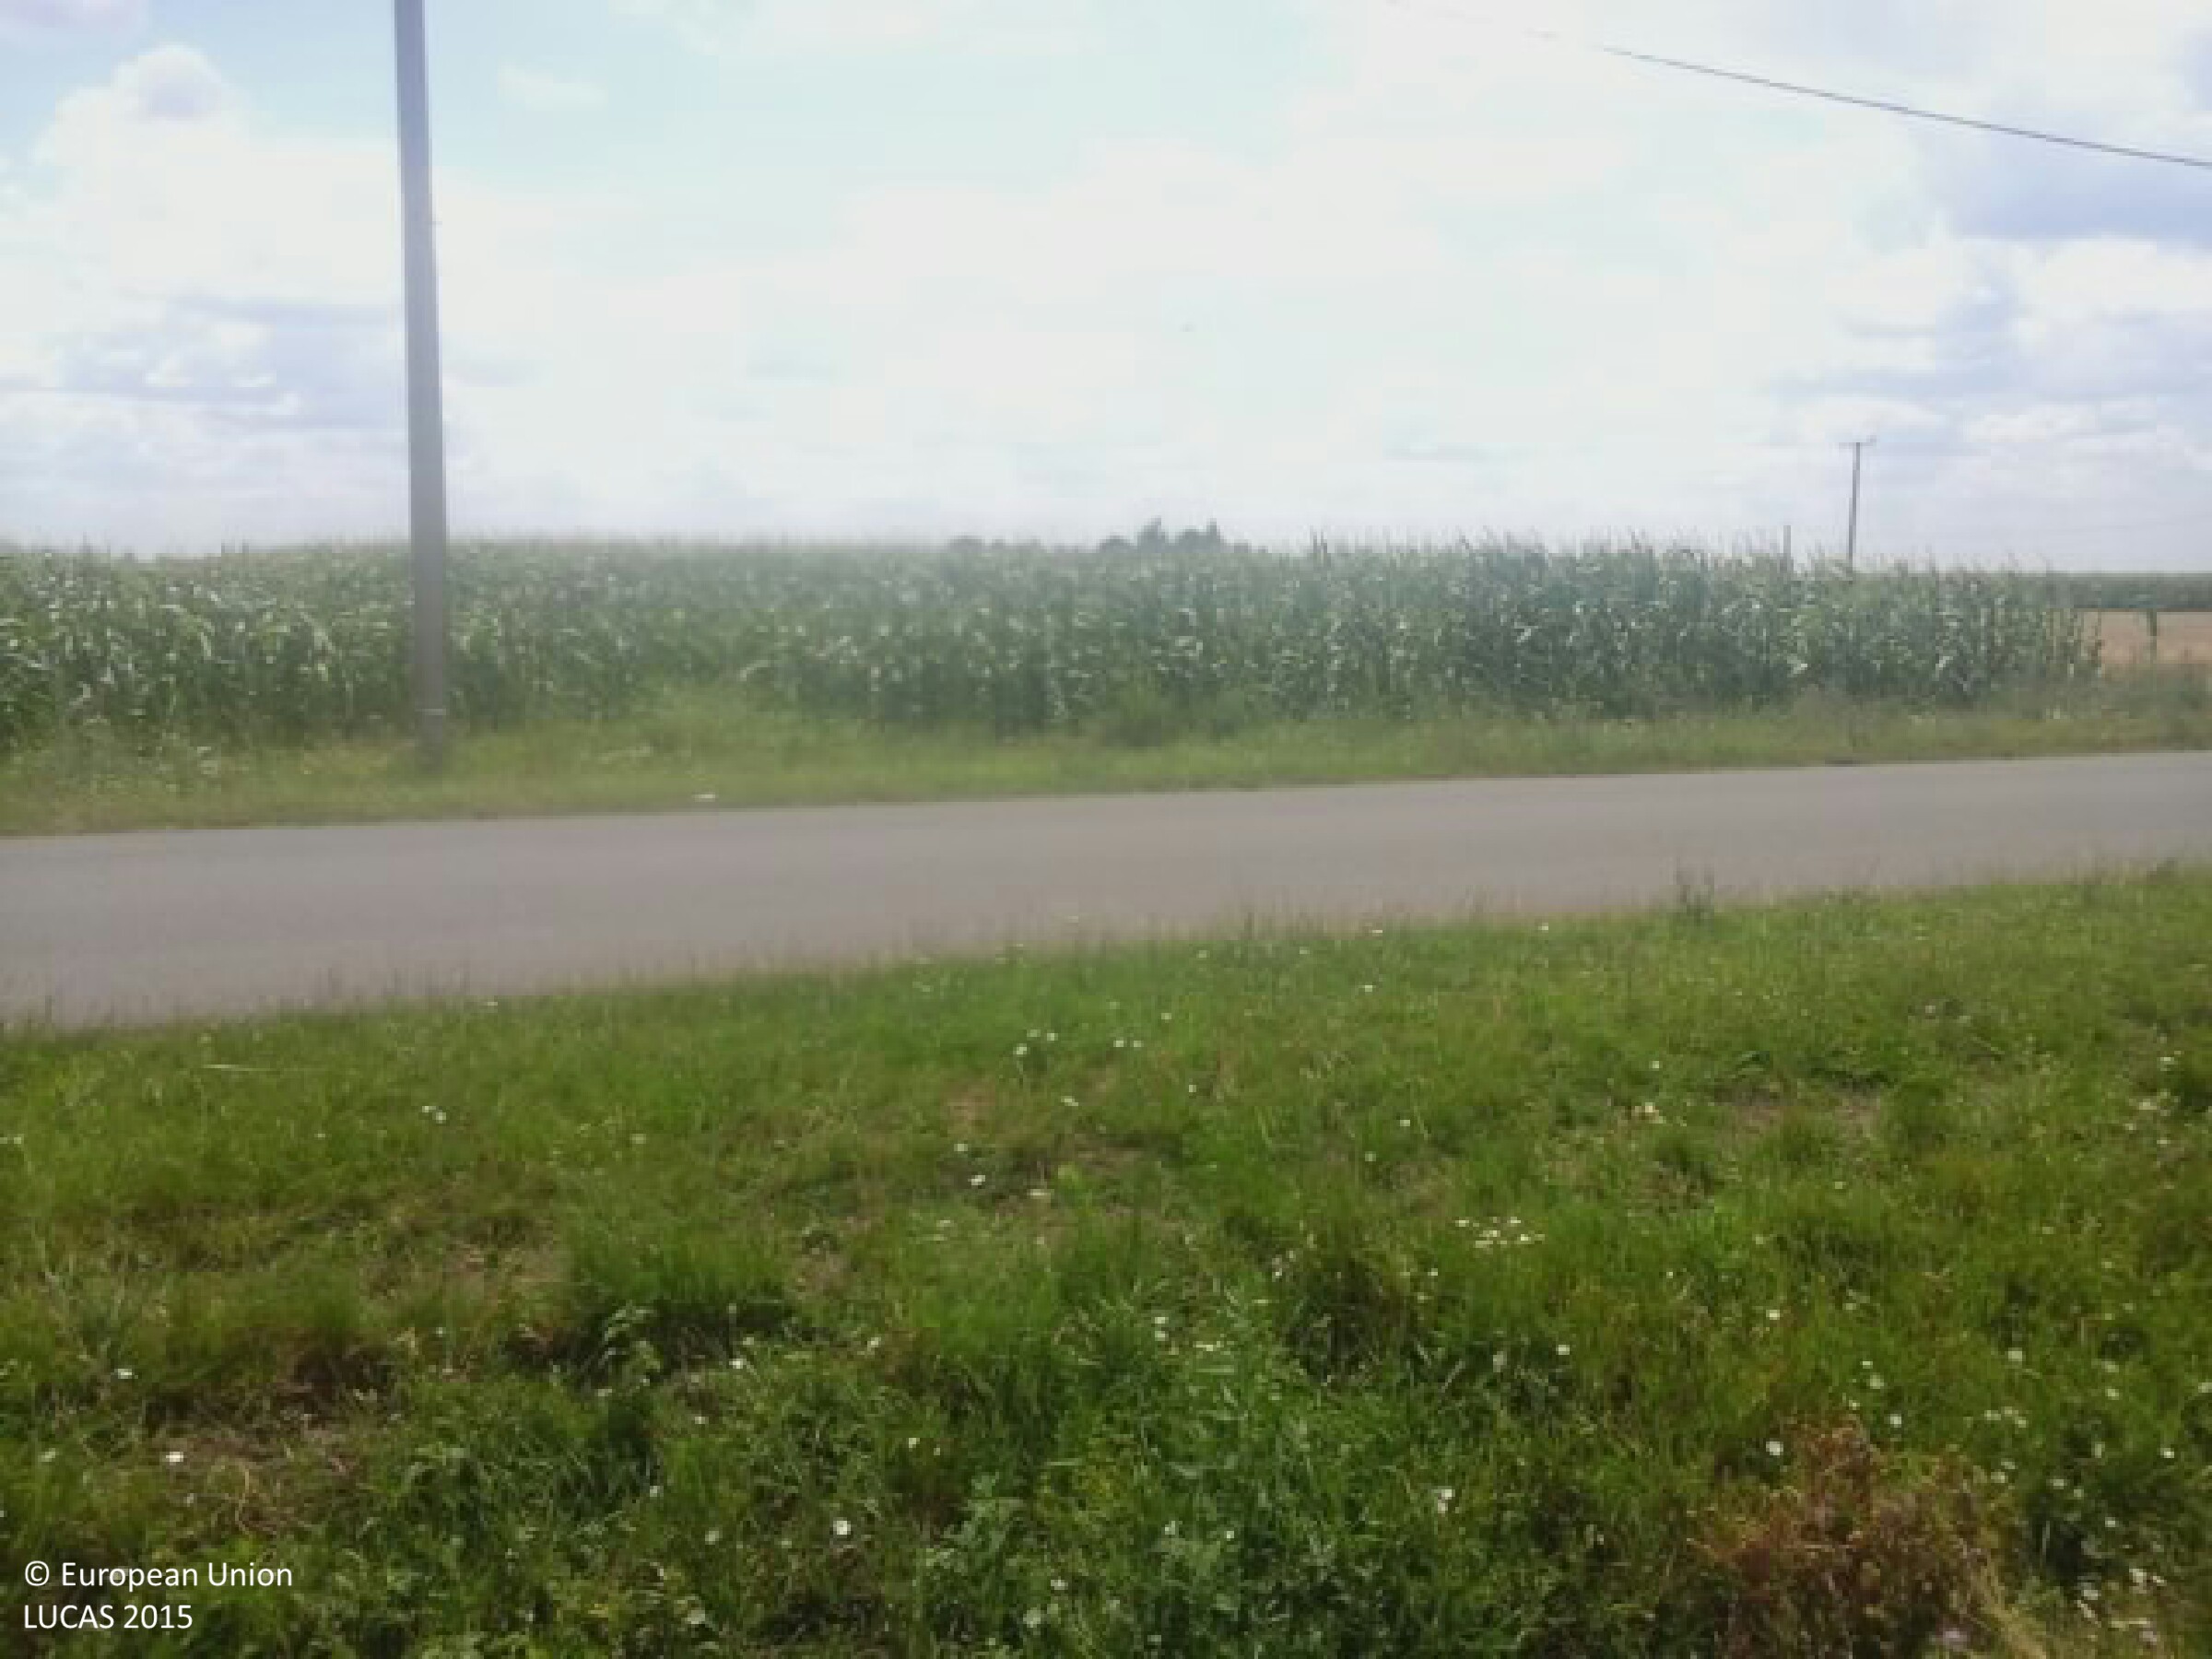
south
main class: Cropland
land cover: Barley
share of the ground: 10 - 25 %
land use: Agriculture (excluding fallow land and kitchen gardens)
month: July
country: HU
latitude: 46.4877
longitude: 20.6716
